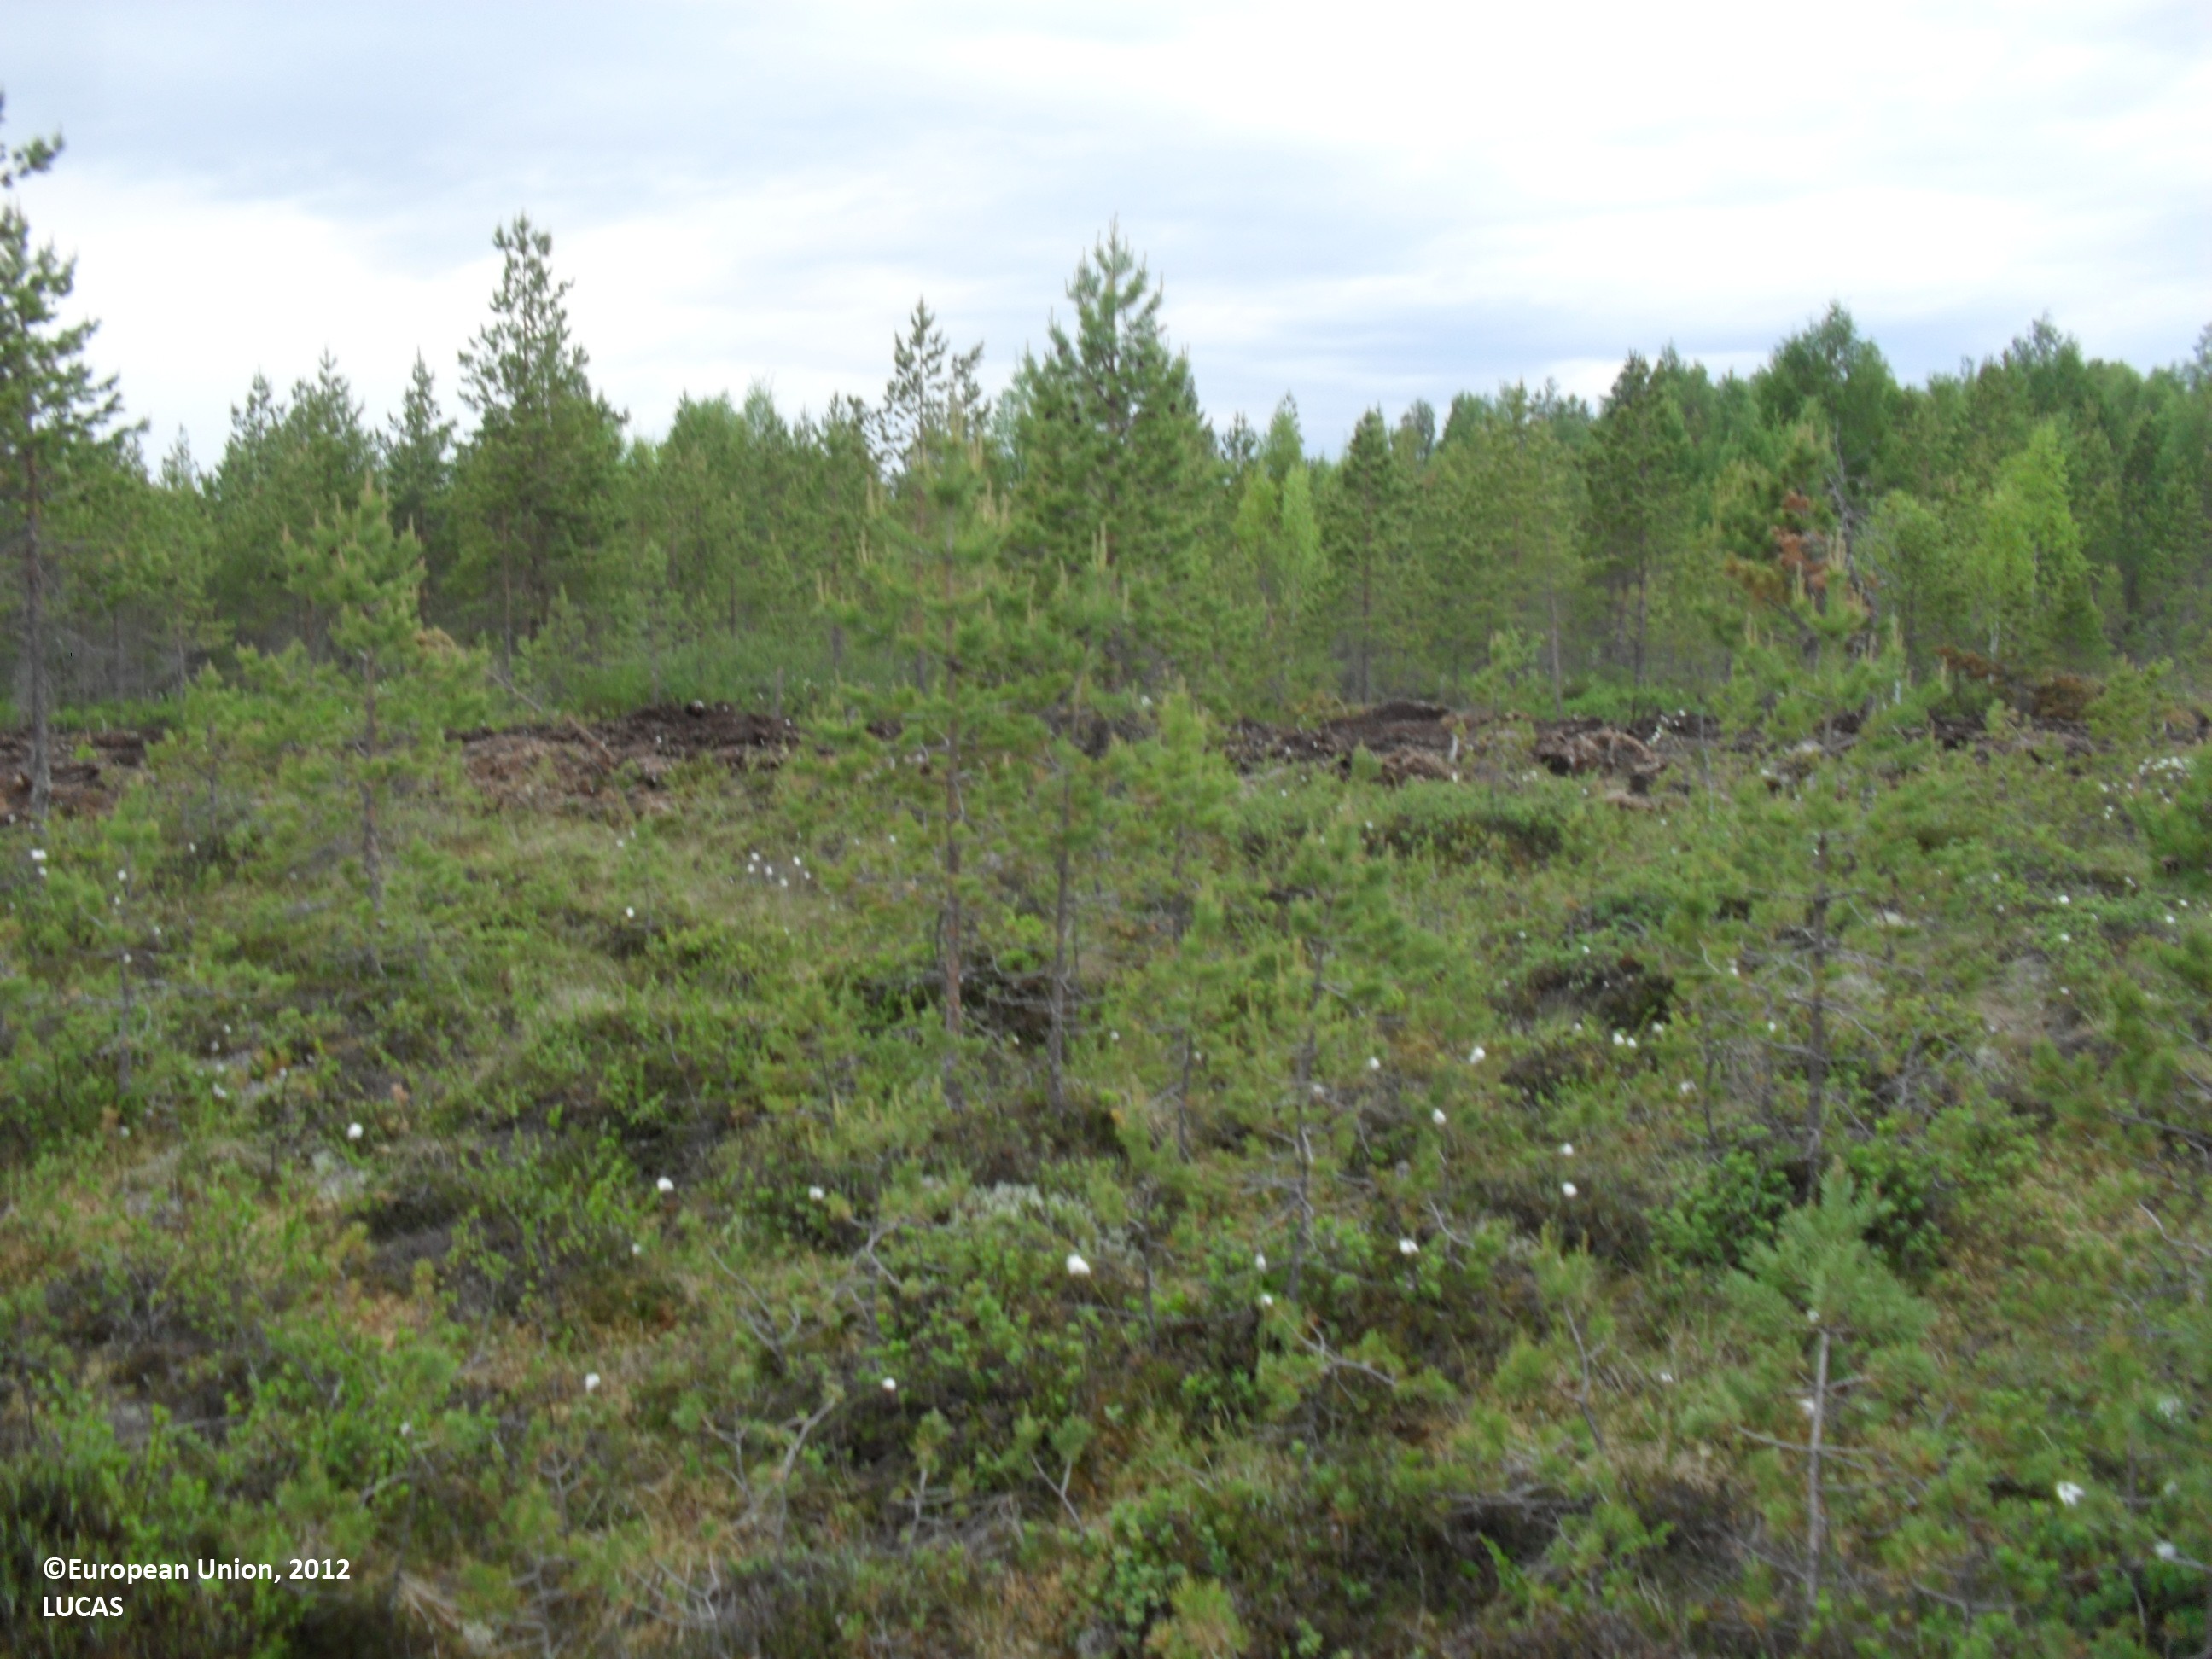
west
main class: Woodland
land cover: Pine dominated mixed woodland
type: mire and swamp forests
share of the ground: 10 - 25 %
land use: Forestry
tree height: < 5 m
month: June
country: FI
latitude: 62.9977
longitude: 23.4309
